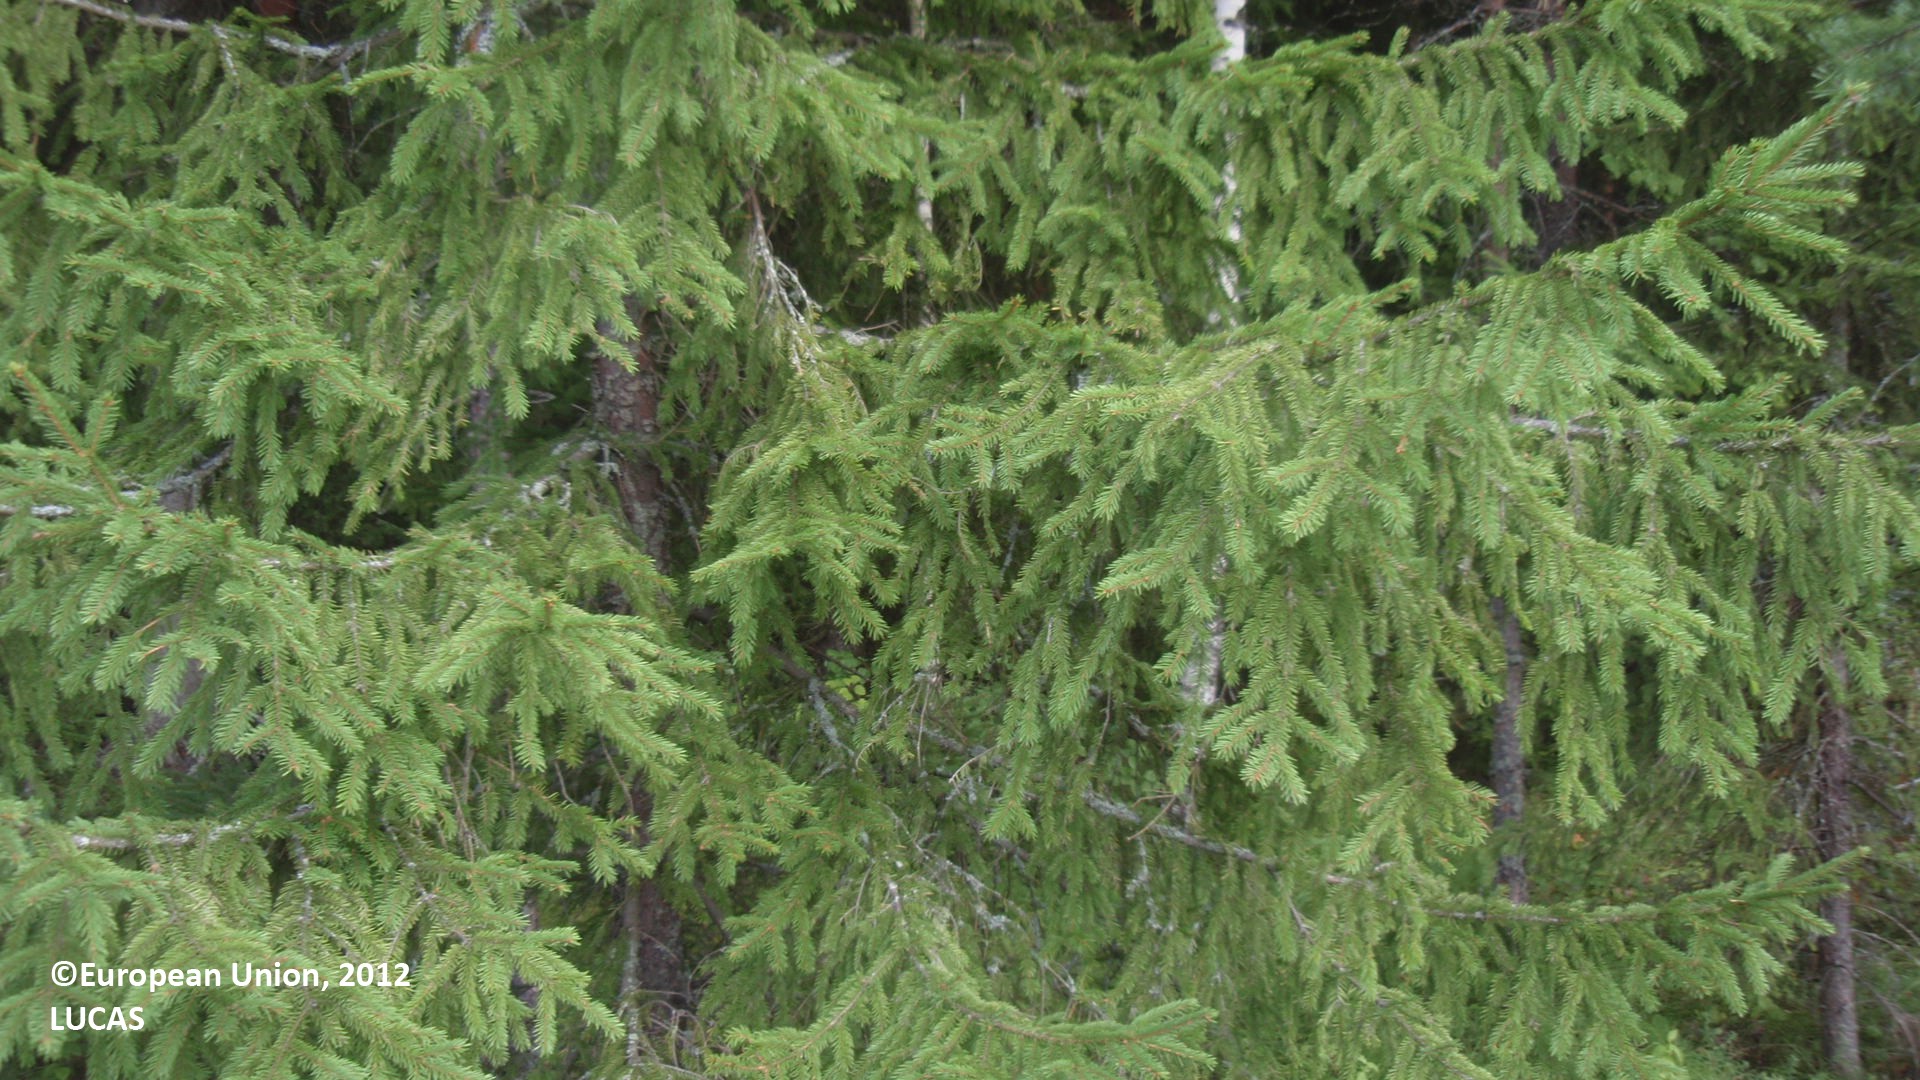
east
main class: Cropland
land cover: Barley
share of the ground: > 75 %
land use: Agriculture (excluding fallow land and kitchen gardens)
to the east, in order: Barley; Grass margins; Ditches and canals; Pine dominated mixed woodland; Spruce dominated mixed woodland; Ditches and canals; Spruce dominated mixed woodland; Broadleaved woodland
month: August
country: FI
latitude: 60.8627
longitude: 26.6352
